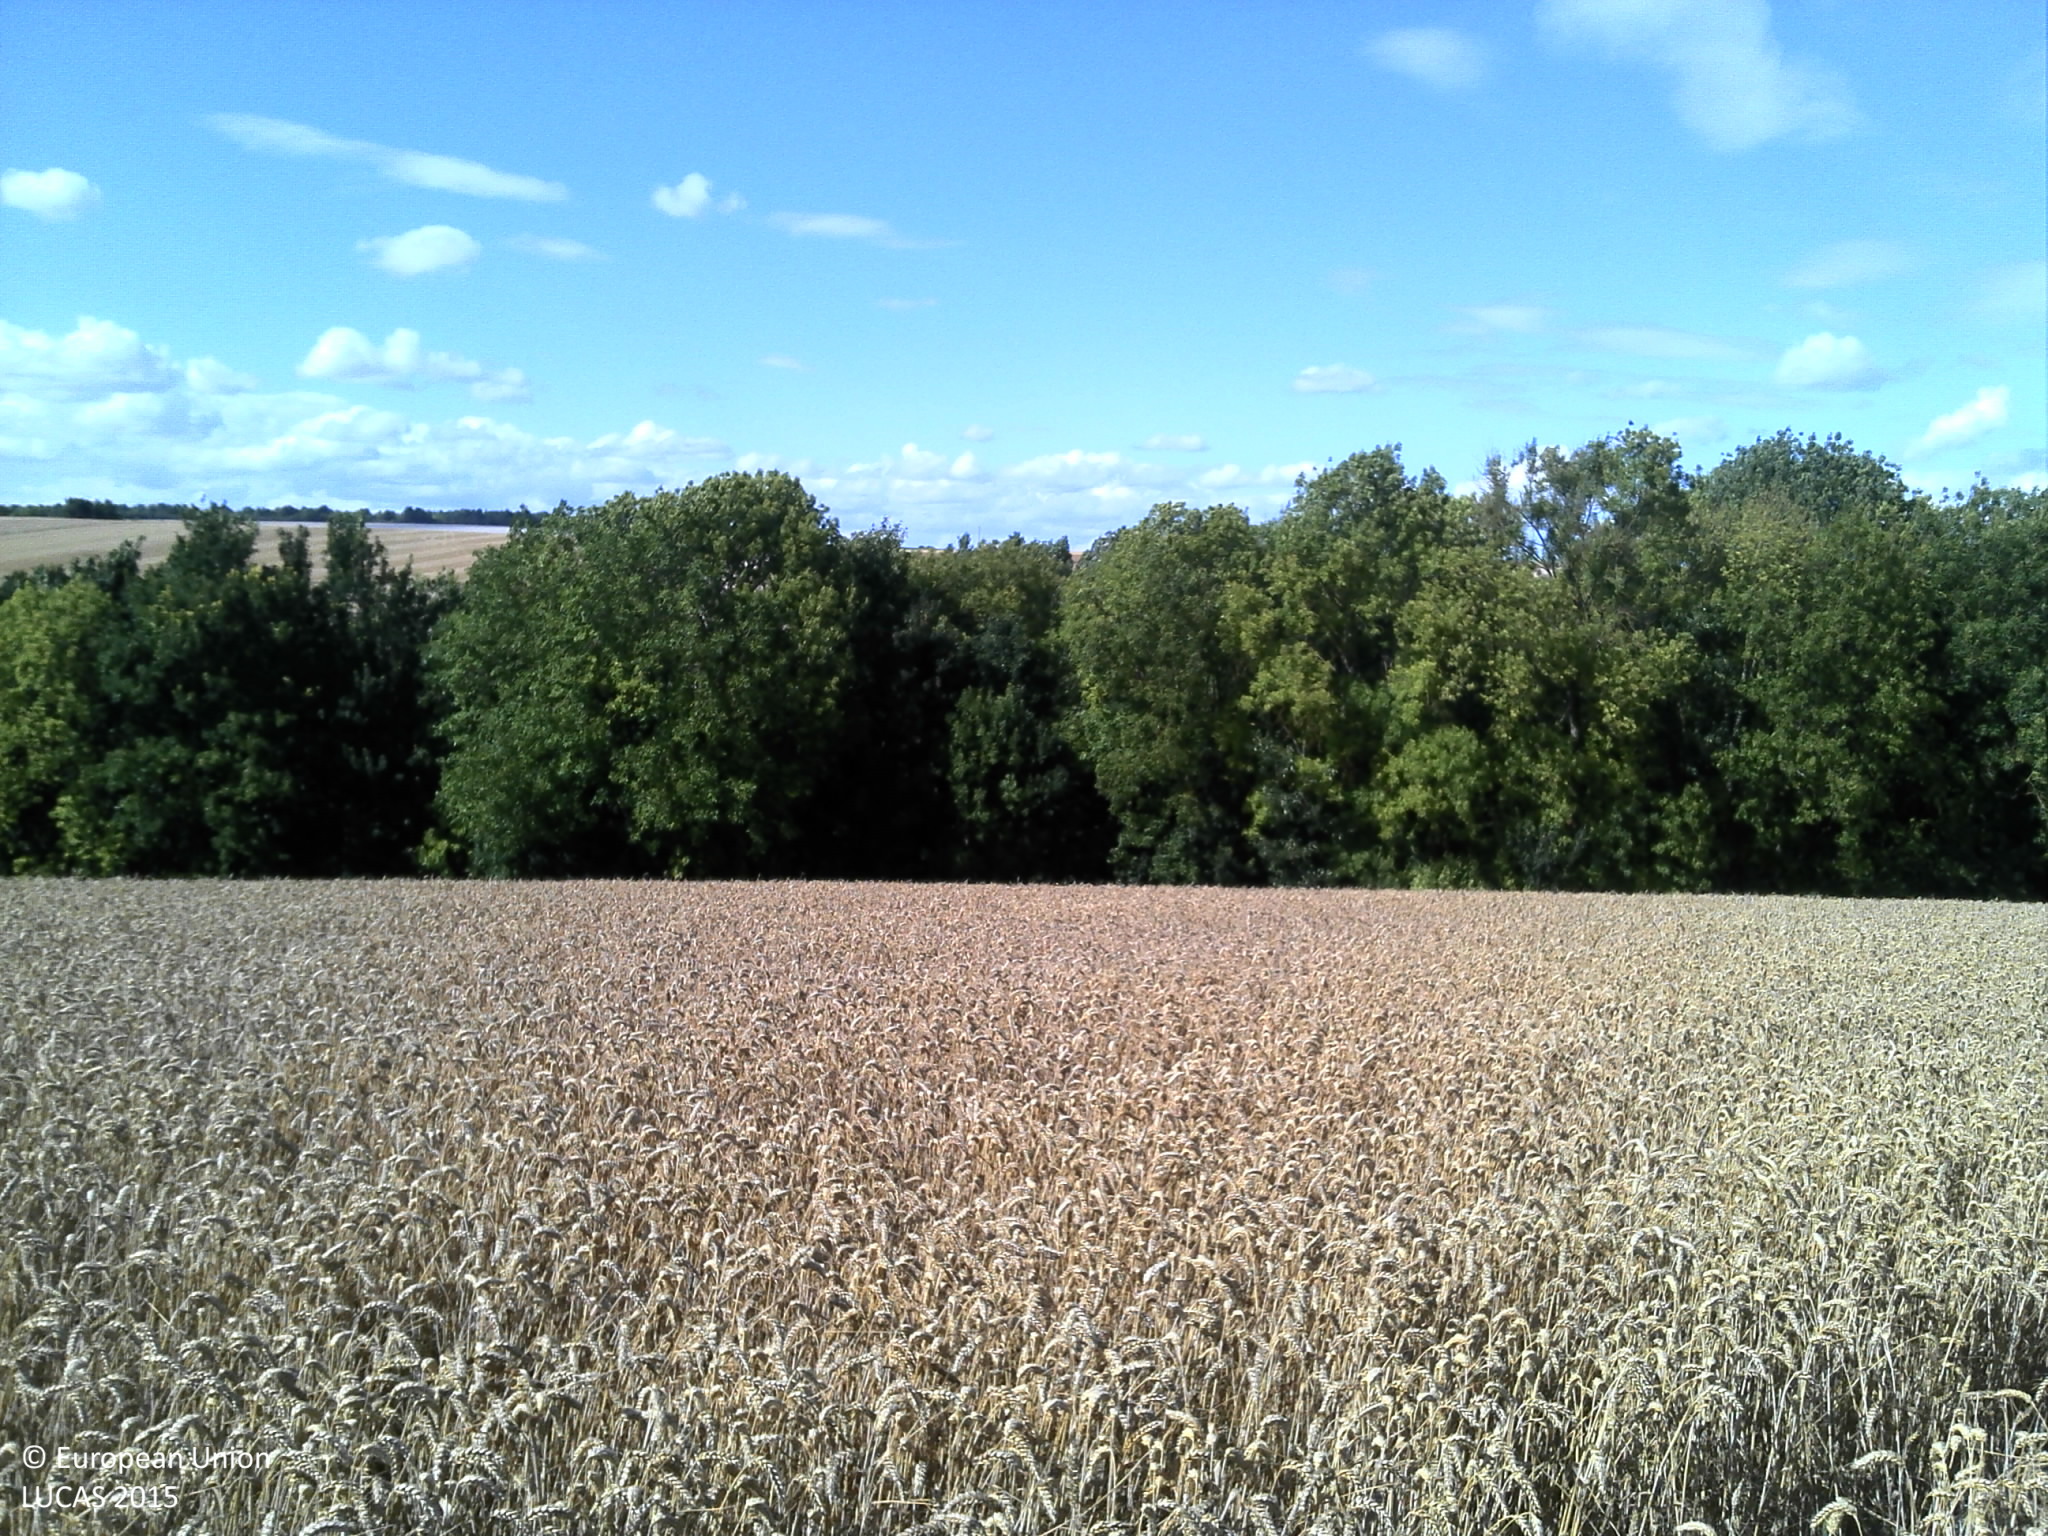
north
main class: Cropland
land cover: Common wheat
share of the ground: > 75 %
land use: Agriculture (excluding fallow land and kitchen gardens)
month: July
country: FR
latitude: 49.2657
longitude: 4.6511
